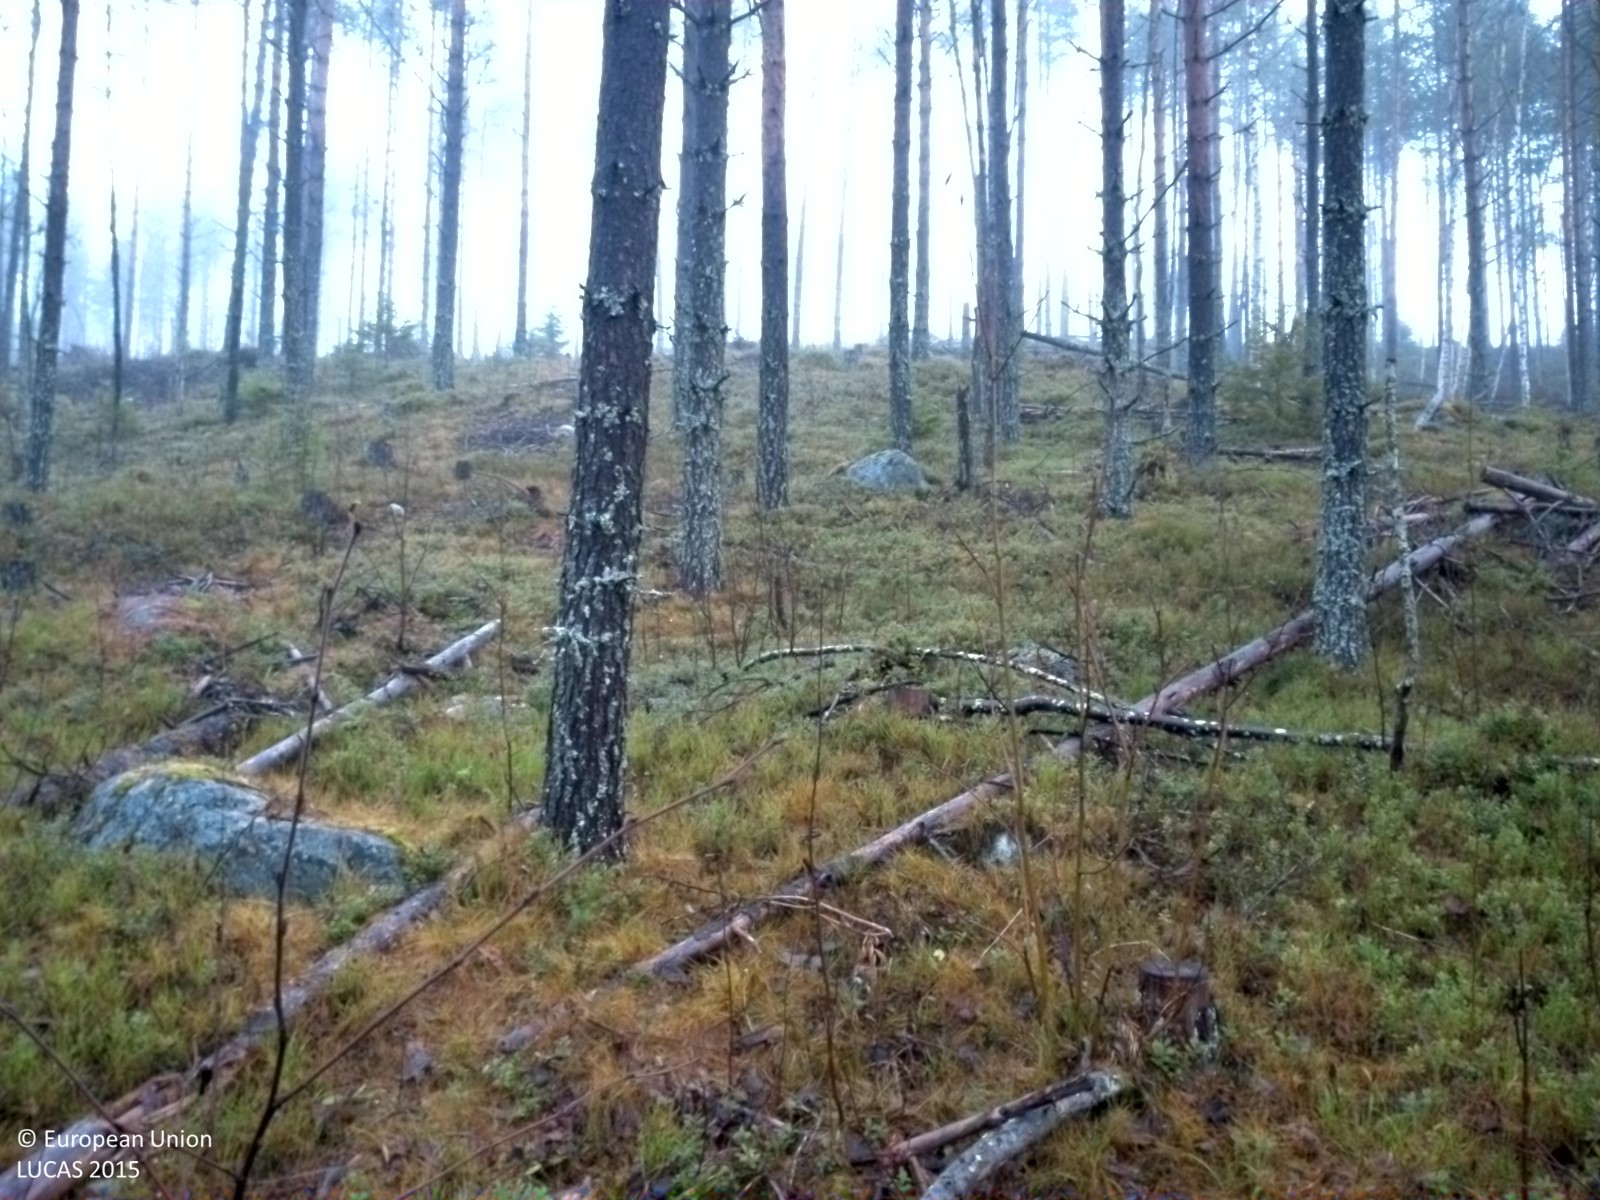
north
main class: Woodland
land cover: Pine dominated coniferous woodland
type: boreal forest
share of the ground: 25 - 50 %
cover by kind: shrubs 40 %, coniferous forest trees 35 %, lichens and mosses 15 %, broadleaved forest trees 5 %, herbaceous plants 5 %
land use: Forestry
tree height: > 5 m
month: November
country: SE
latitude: 64.0292
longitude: 16.0501
